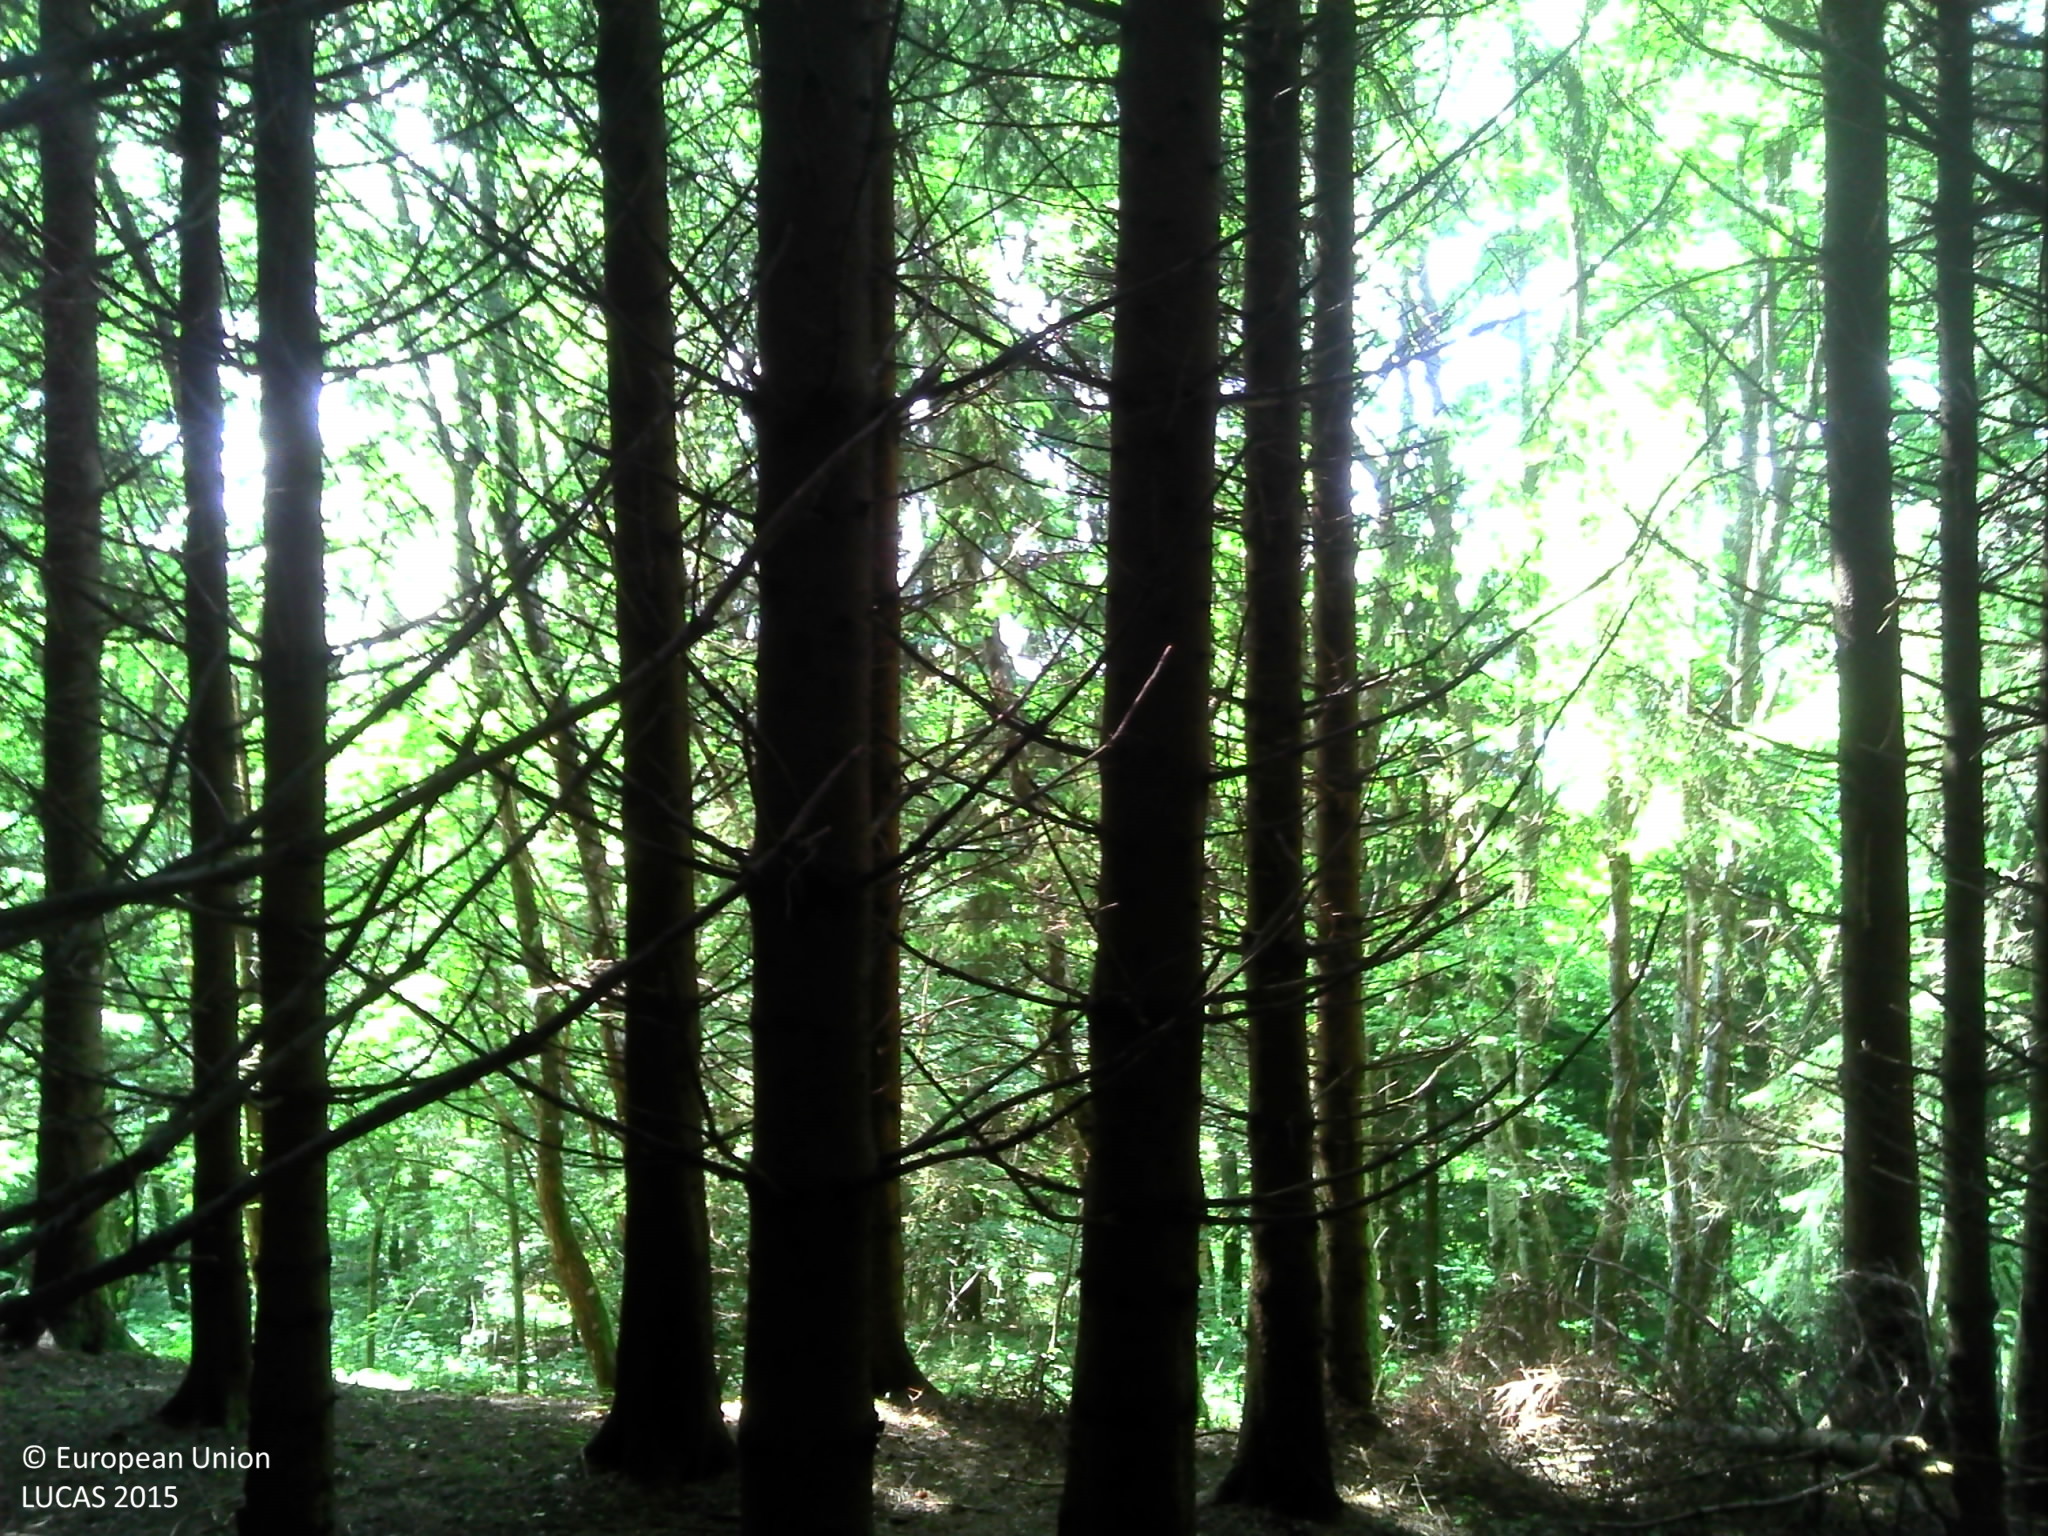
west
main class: Woodland
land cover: Spruce dominated coniferous woodland
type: alpine coniferous forest
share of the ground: > 75 %
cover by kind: coniferous forest trees 100 %
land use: Forestry
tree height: > 5 m
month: June
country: FR
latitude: 45.4894
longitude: 6.1789
